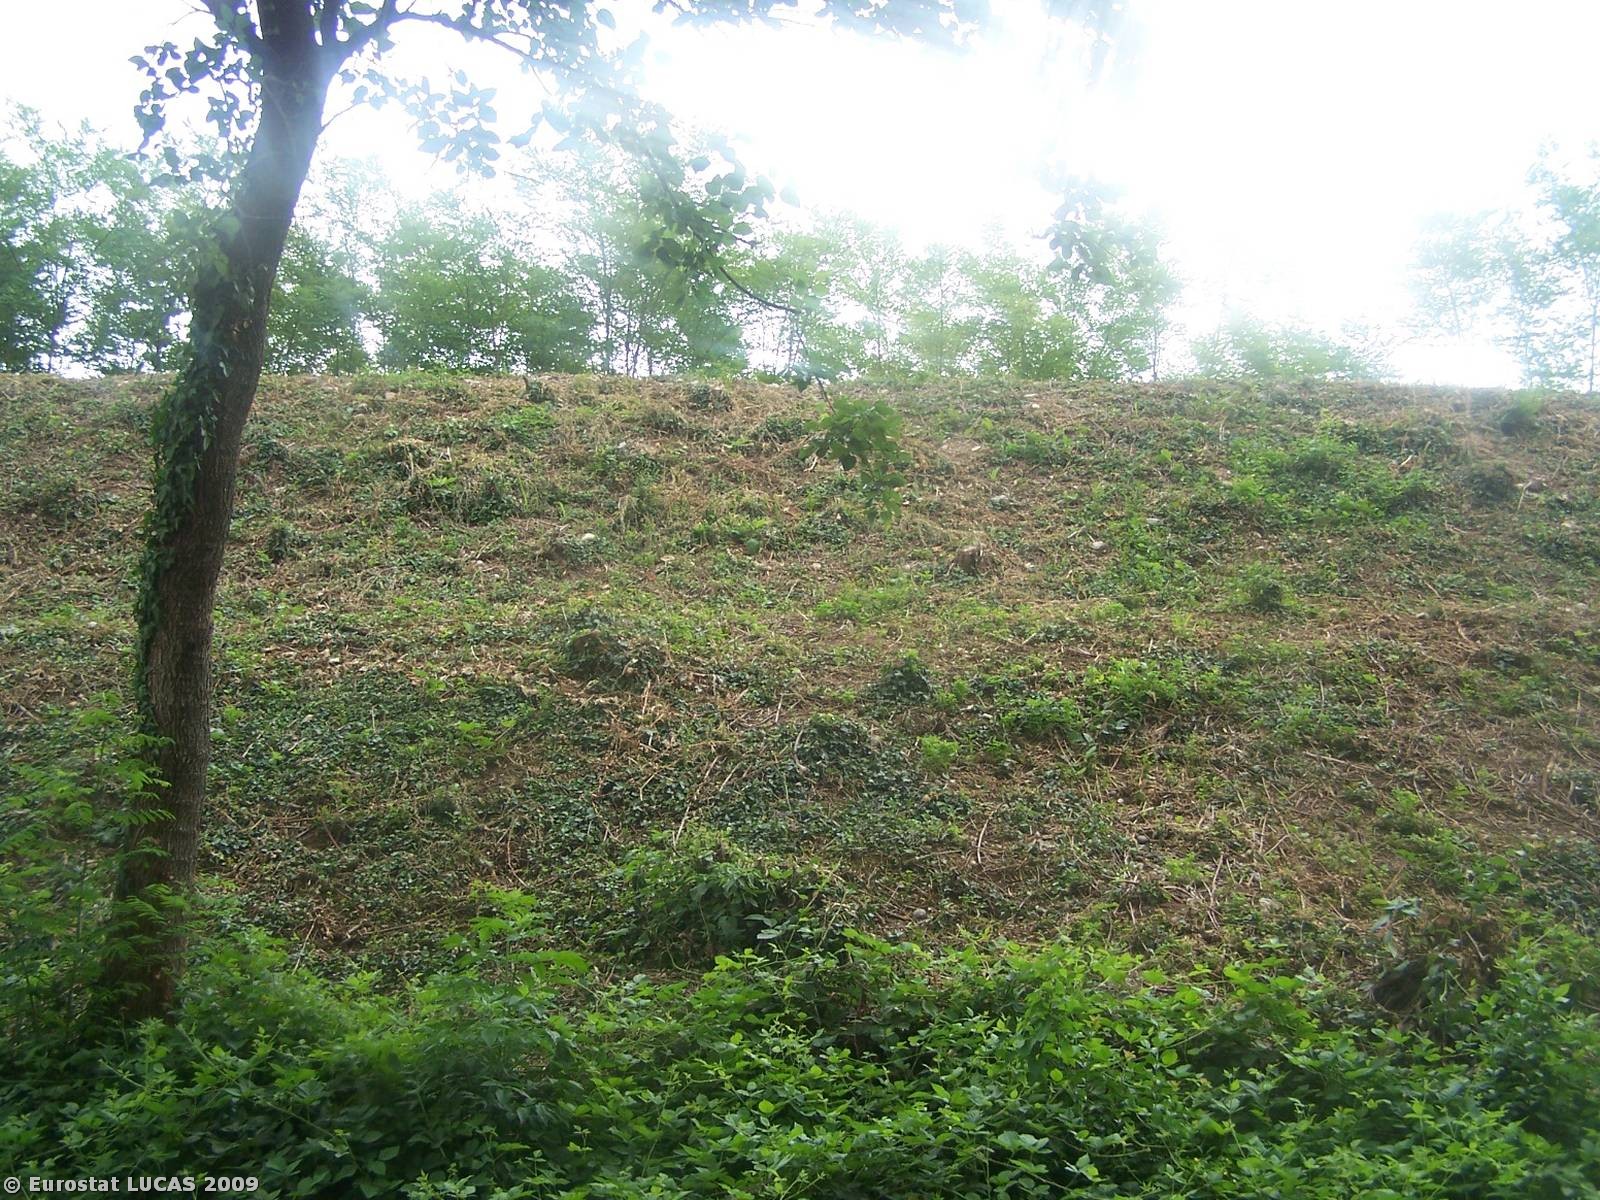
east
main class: Woodland
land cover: Broadleaved woodland
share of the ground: > 75 %
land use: Unused
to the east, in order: Broadleaved woodland; Grassland with sparse tree/shrub cover; Inland water bodies; Broadleaved woodland; Maize; Electric lines; Tracks; Maize; Lucerne; Maize
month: July
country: IT
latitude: 46.0753
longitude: 12.9834
